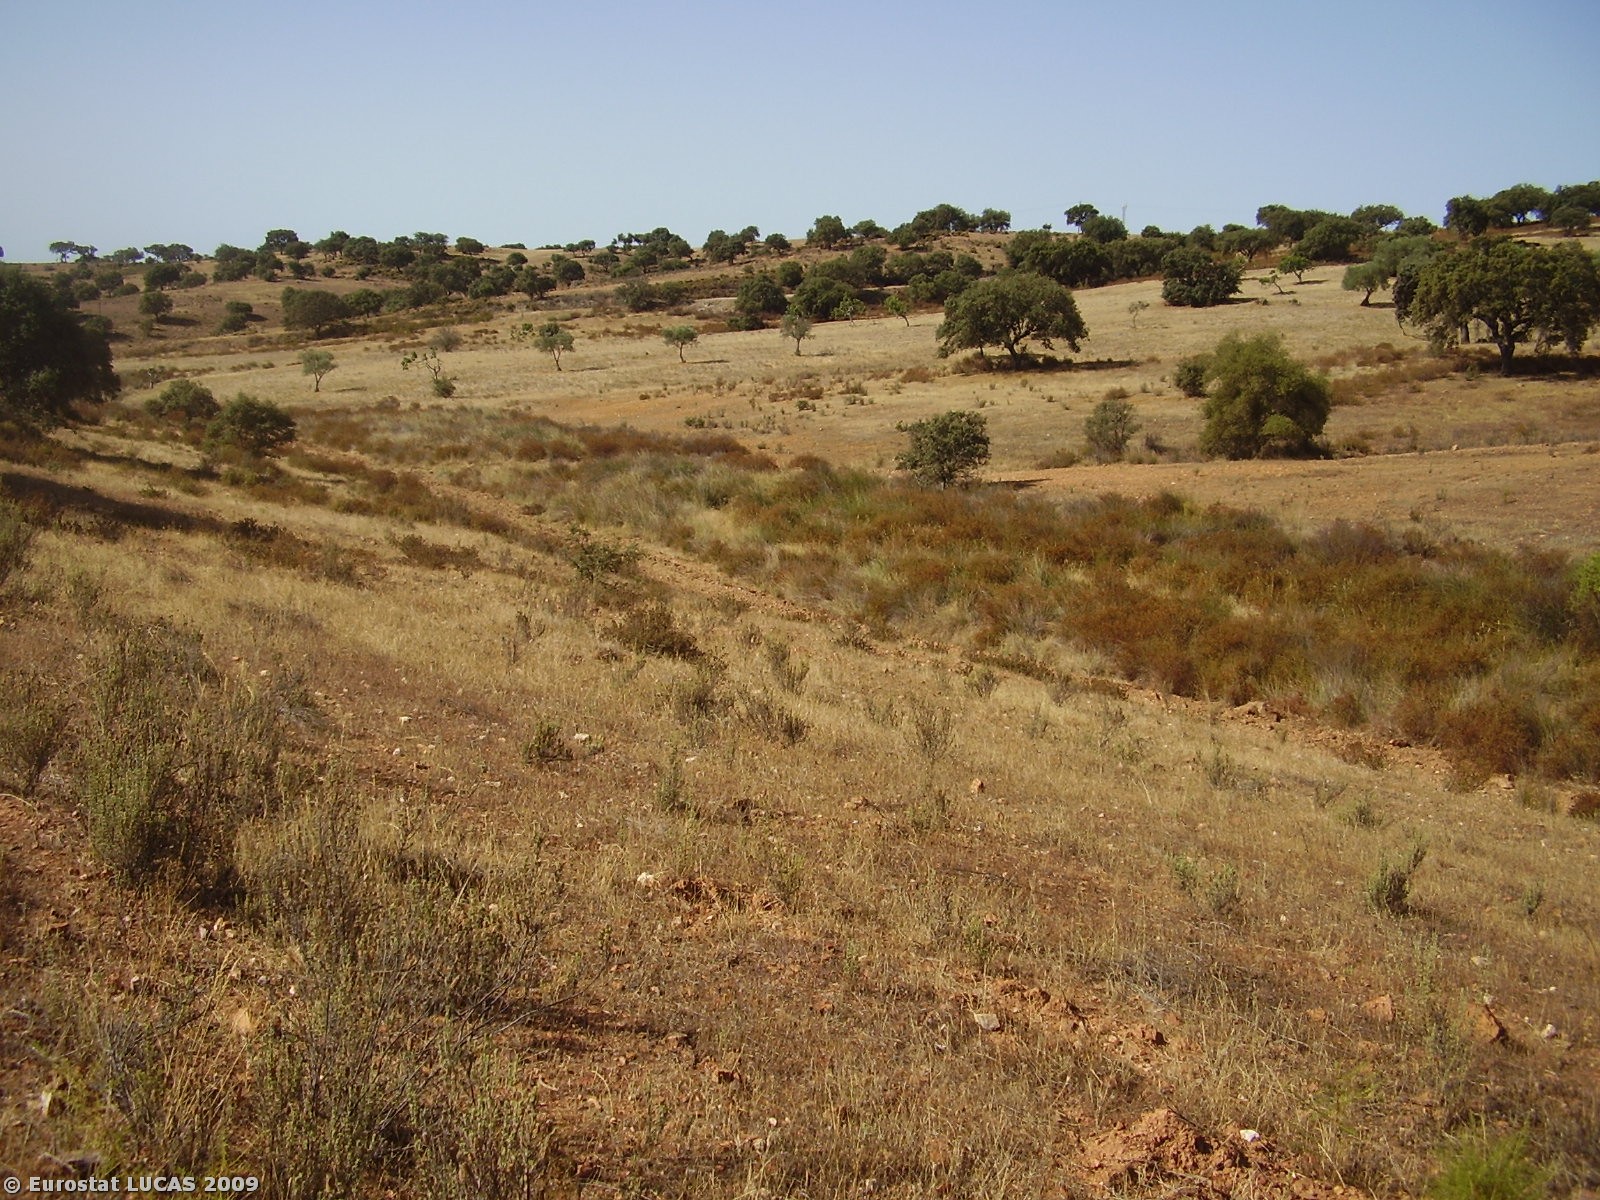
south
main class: Grassland
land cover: Grassland with sparse tree/shrub cover
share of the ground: > 75 %
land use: Fallow land
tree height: > 5 m
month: July
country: PT
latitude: 37.7030
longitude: -7.4916
